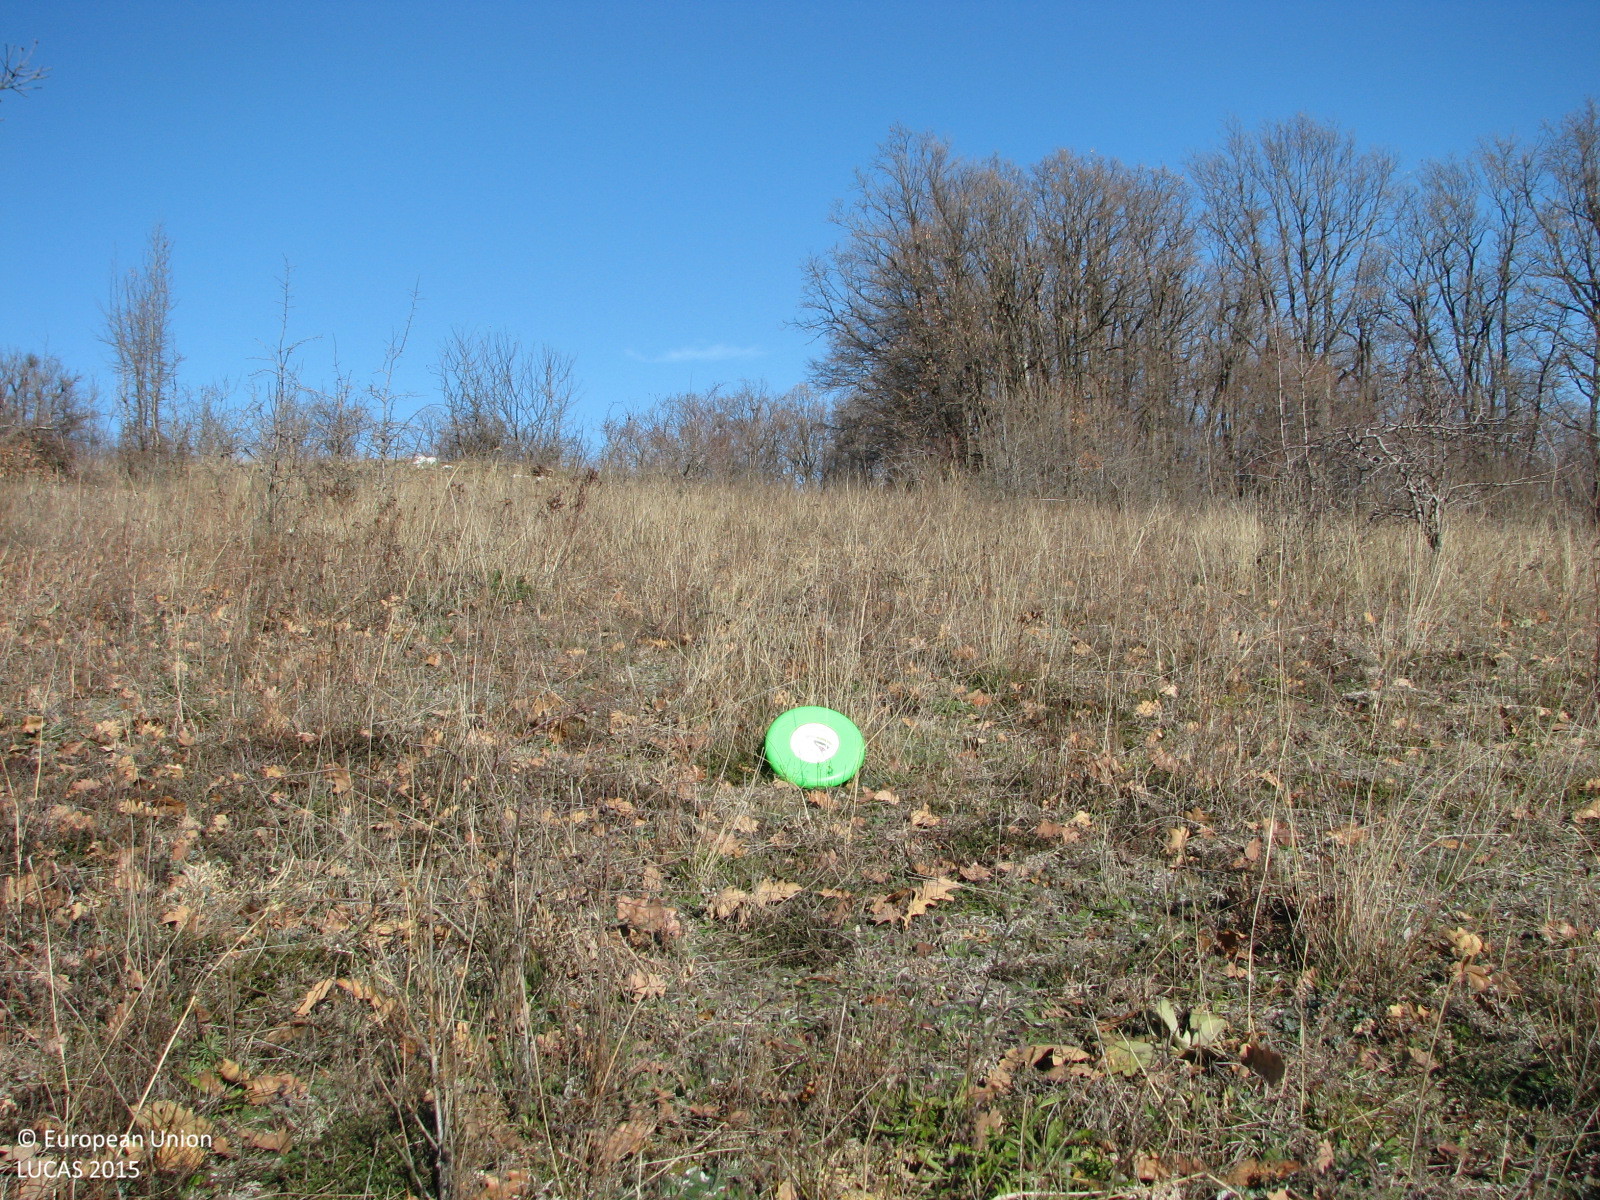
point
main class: Grassland
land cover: Grassland with sparse tree/shrub cover
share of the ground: > 75 %
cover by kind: herbaceous plants 90 %, broadleaved forest trees 5 %, shrubs 5 %
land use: Agriculture (excluding fallow land and kitchen gardens)
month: December
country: BG
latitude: 42.4815
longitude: 25.0109
